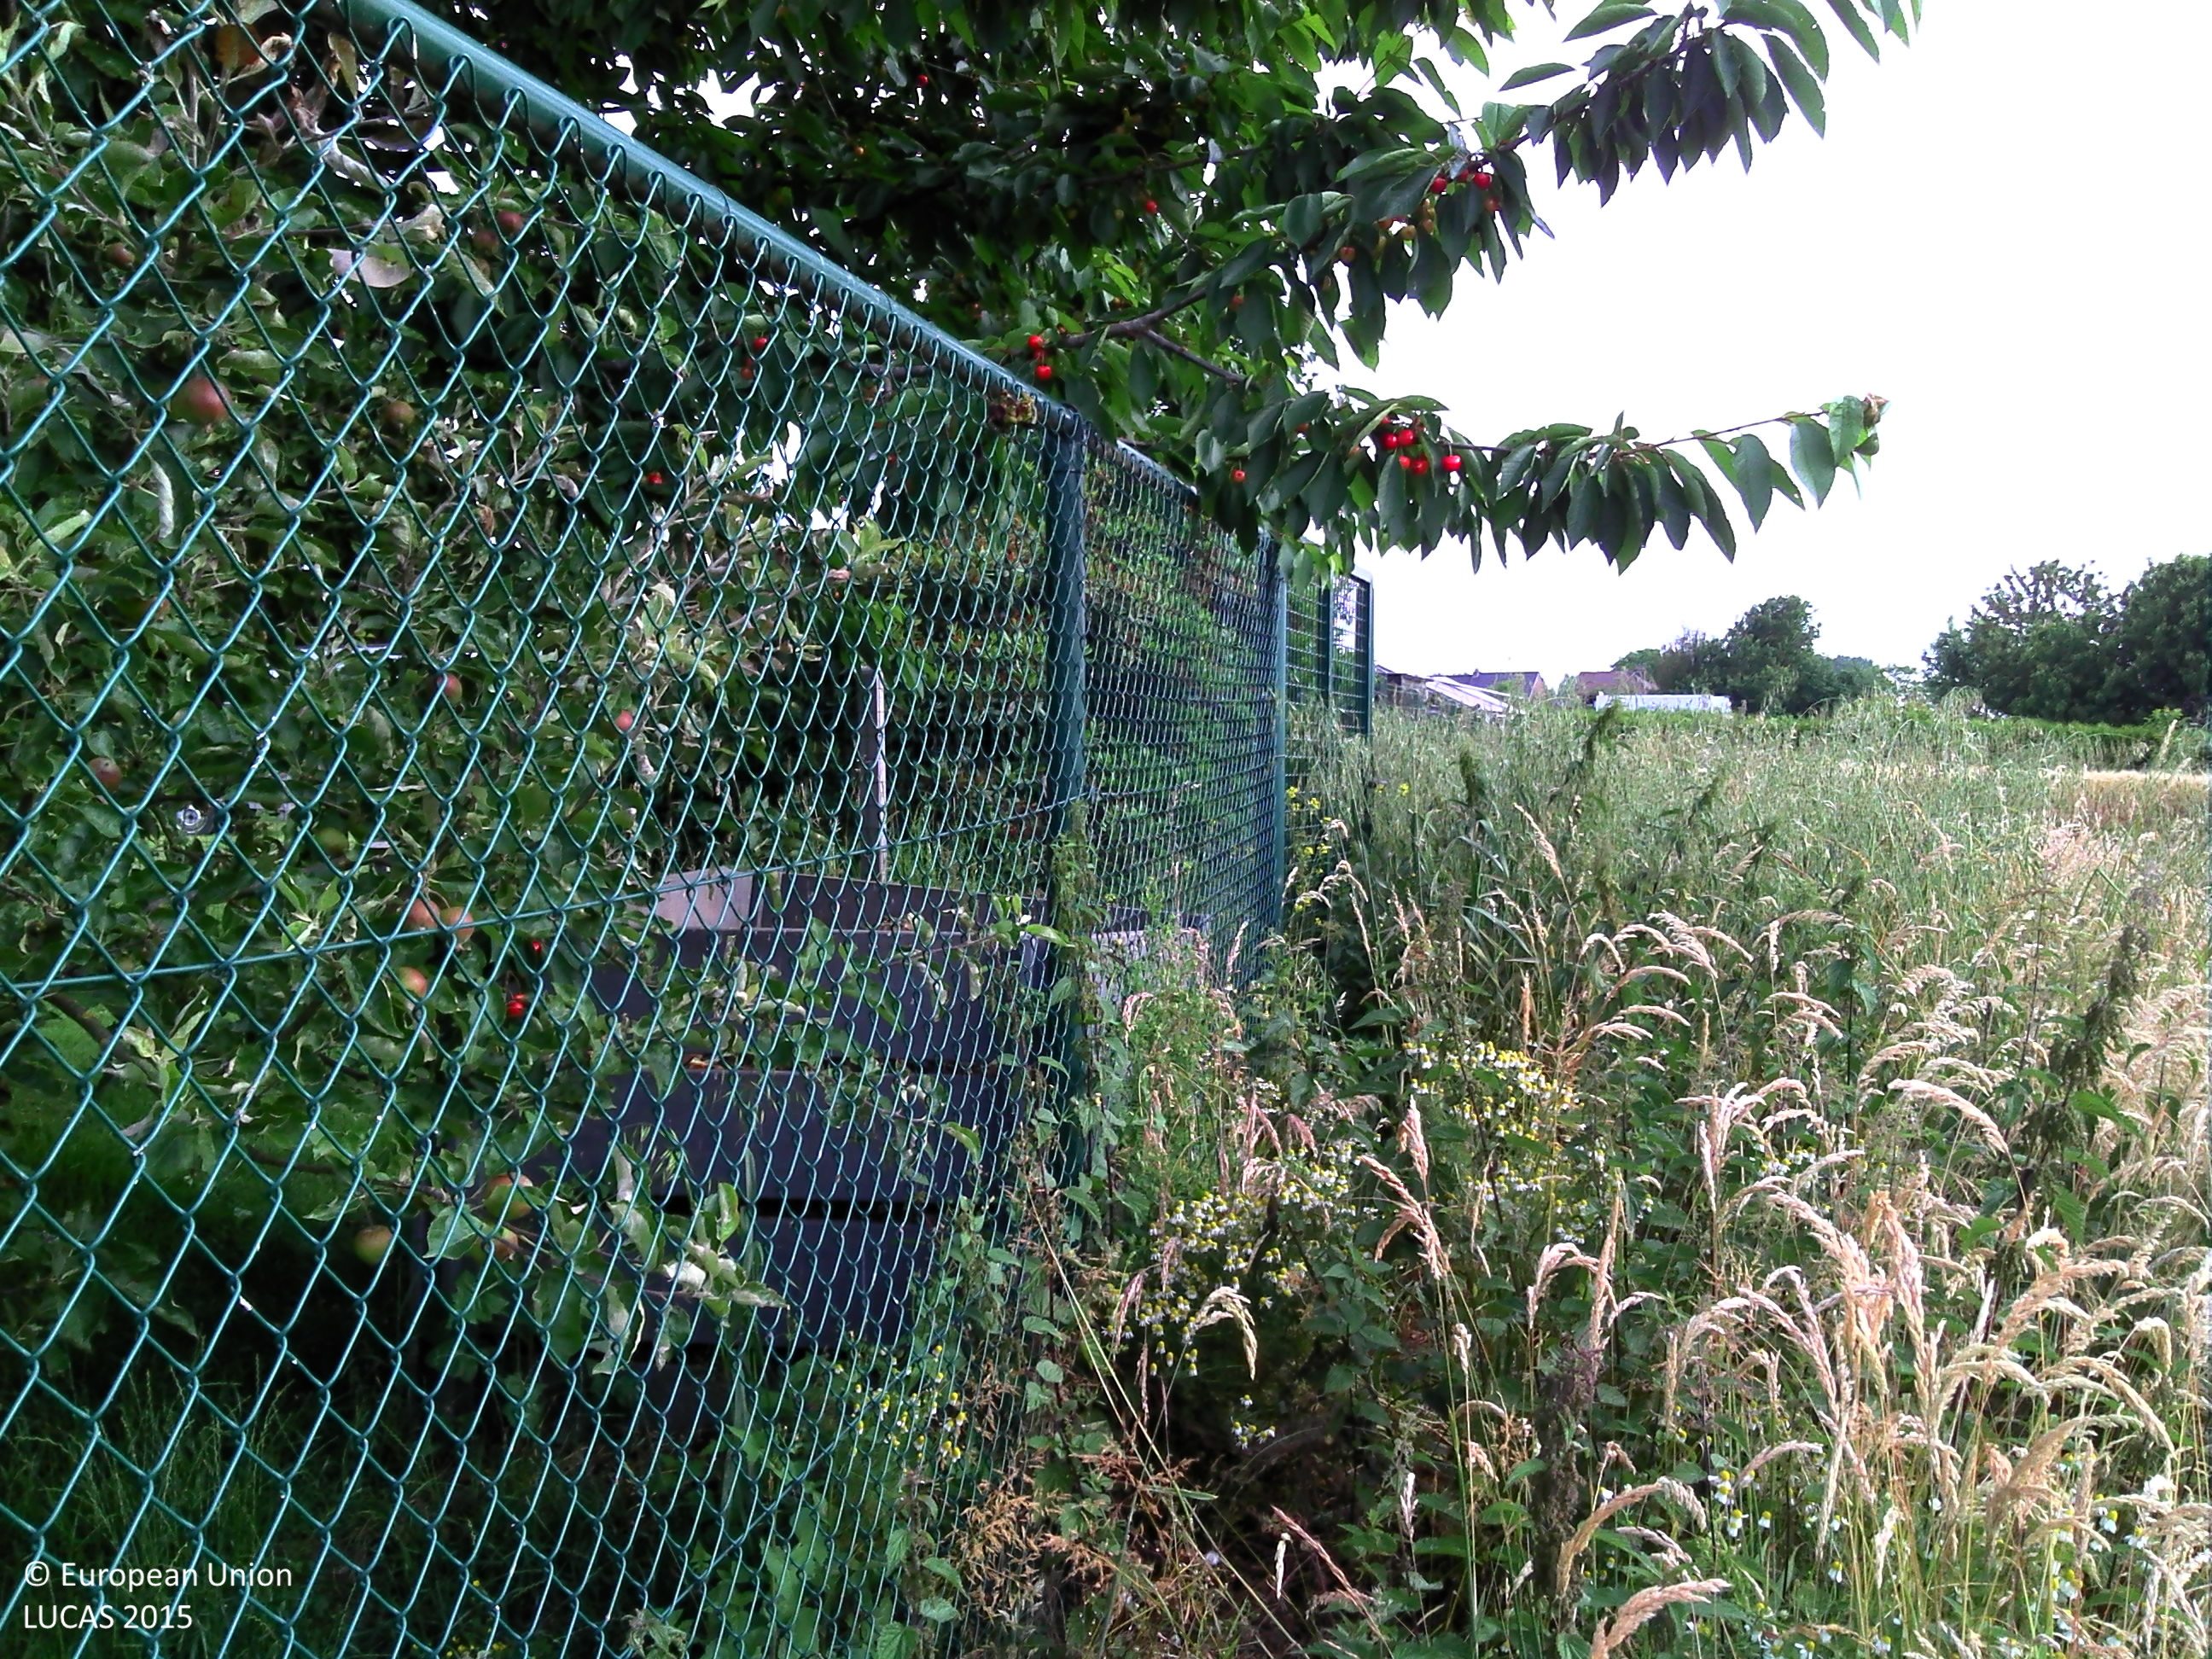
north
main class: Grassland
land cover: Grassland without tree/shrub cover
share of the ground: > 75 %
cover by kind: herbaceous plants 100 %
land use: Residential
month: June
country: BE
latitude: 50.8528
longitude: 5.5237
